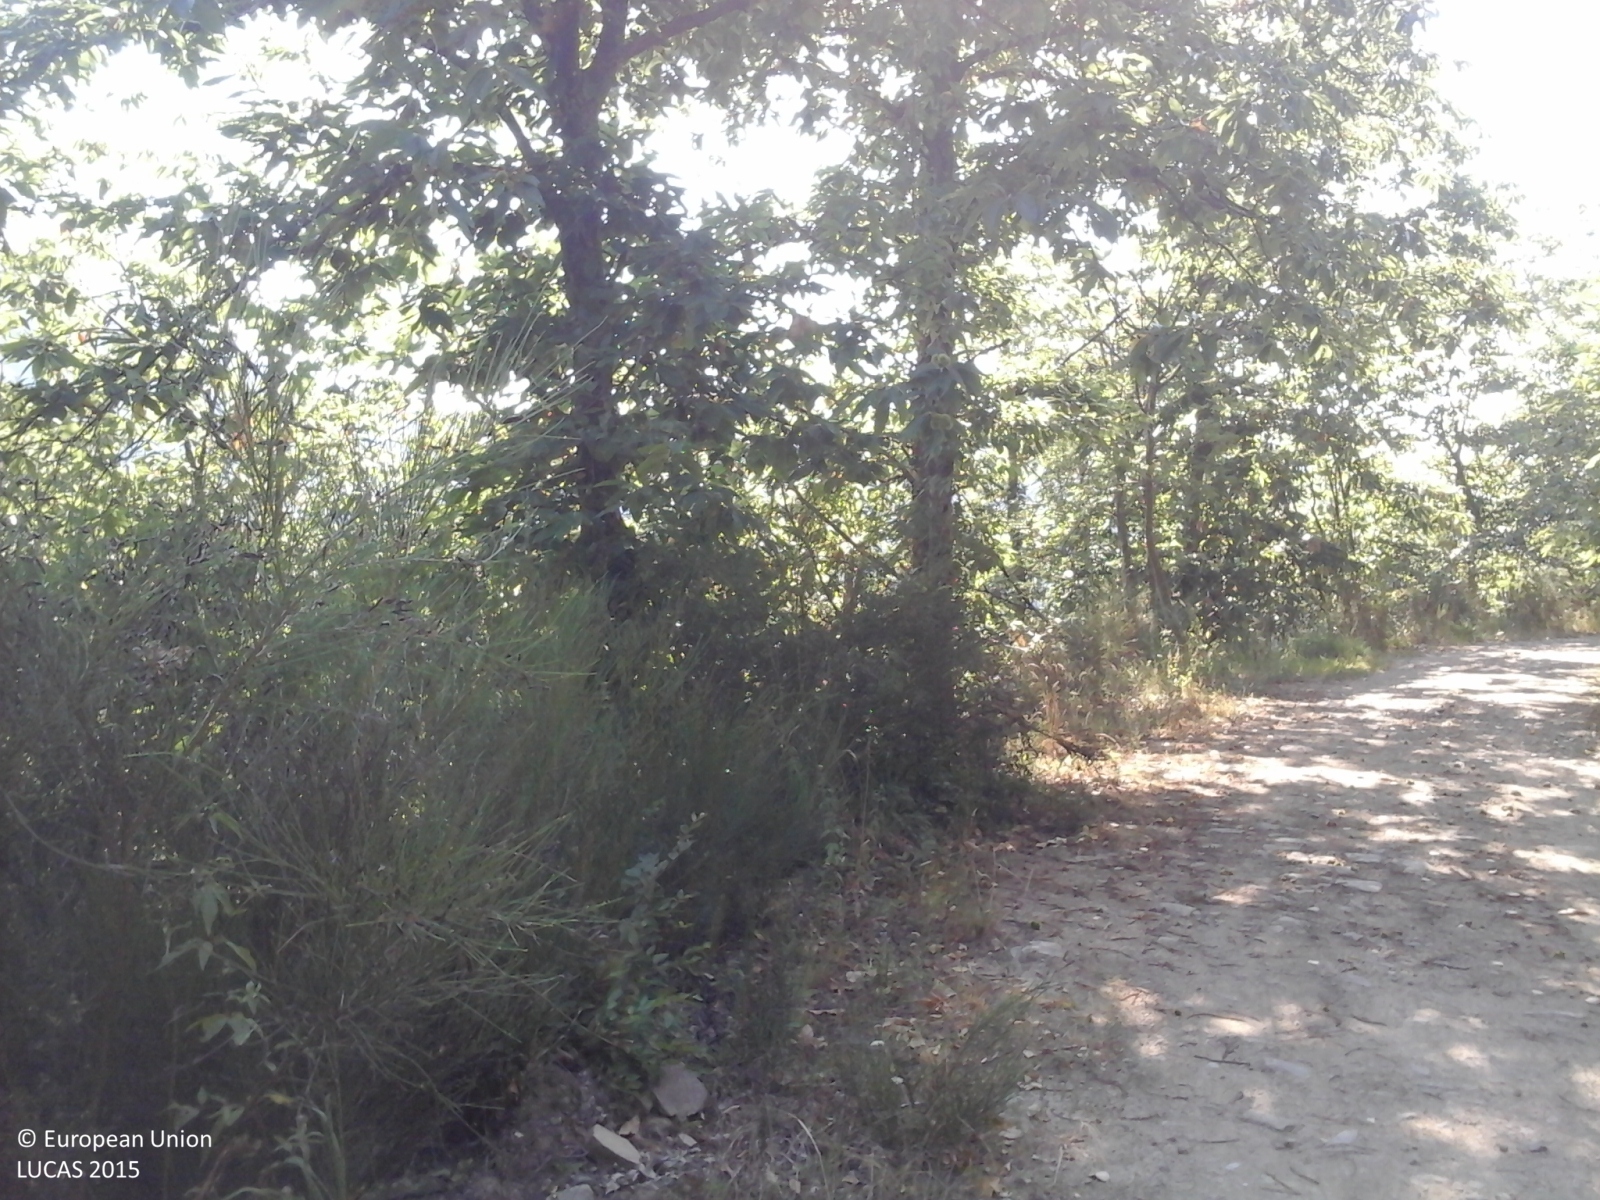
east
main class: Woodland
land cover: Broadleaved woodland
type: thermophilous deciduous forest
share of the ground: > 75 %
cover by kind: broadleaved forest trees 100 %
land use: Forestry
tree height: > 5 m
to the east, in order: Broadleaved woodland; Tracks; Broadleaved woodland; Tracks; Broadleaved woodland
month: August
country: IT
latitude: 43.9696
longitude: 10.6590
